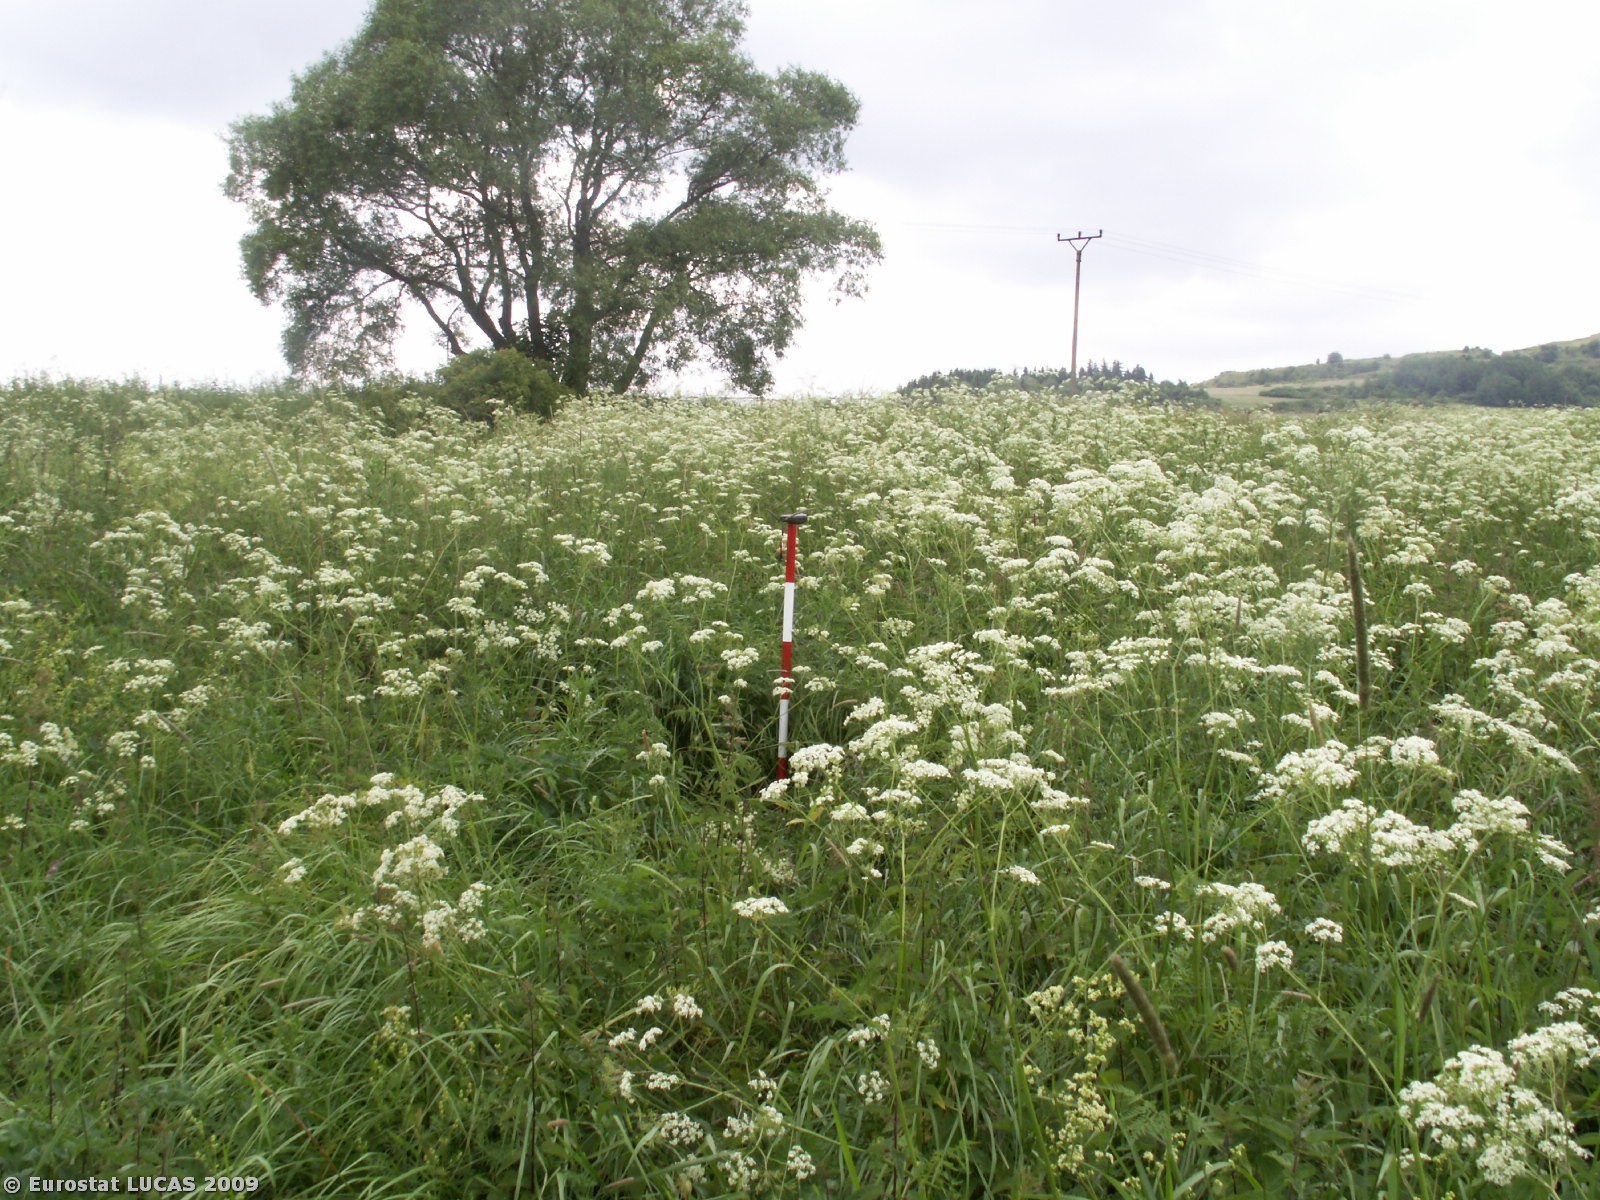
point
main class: Grassland
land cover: Spontaneously vegetated surfaces
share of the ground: > 75 %
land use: Fallow land
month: June
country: CZ
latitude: 50.1625
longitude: 13.0096
